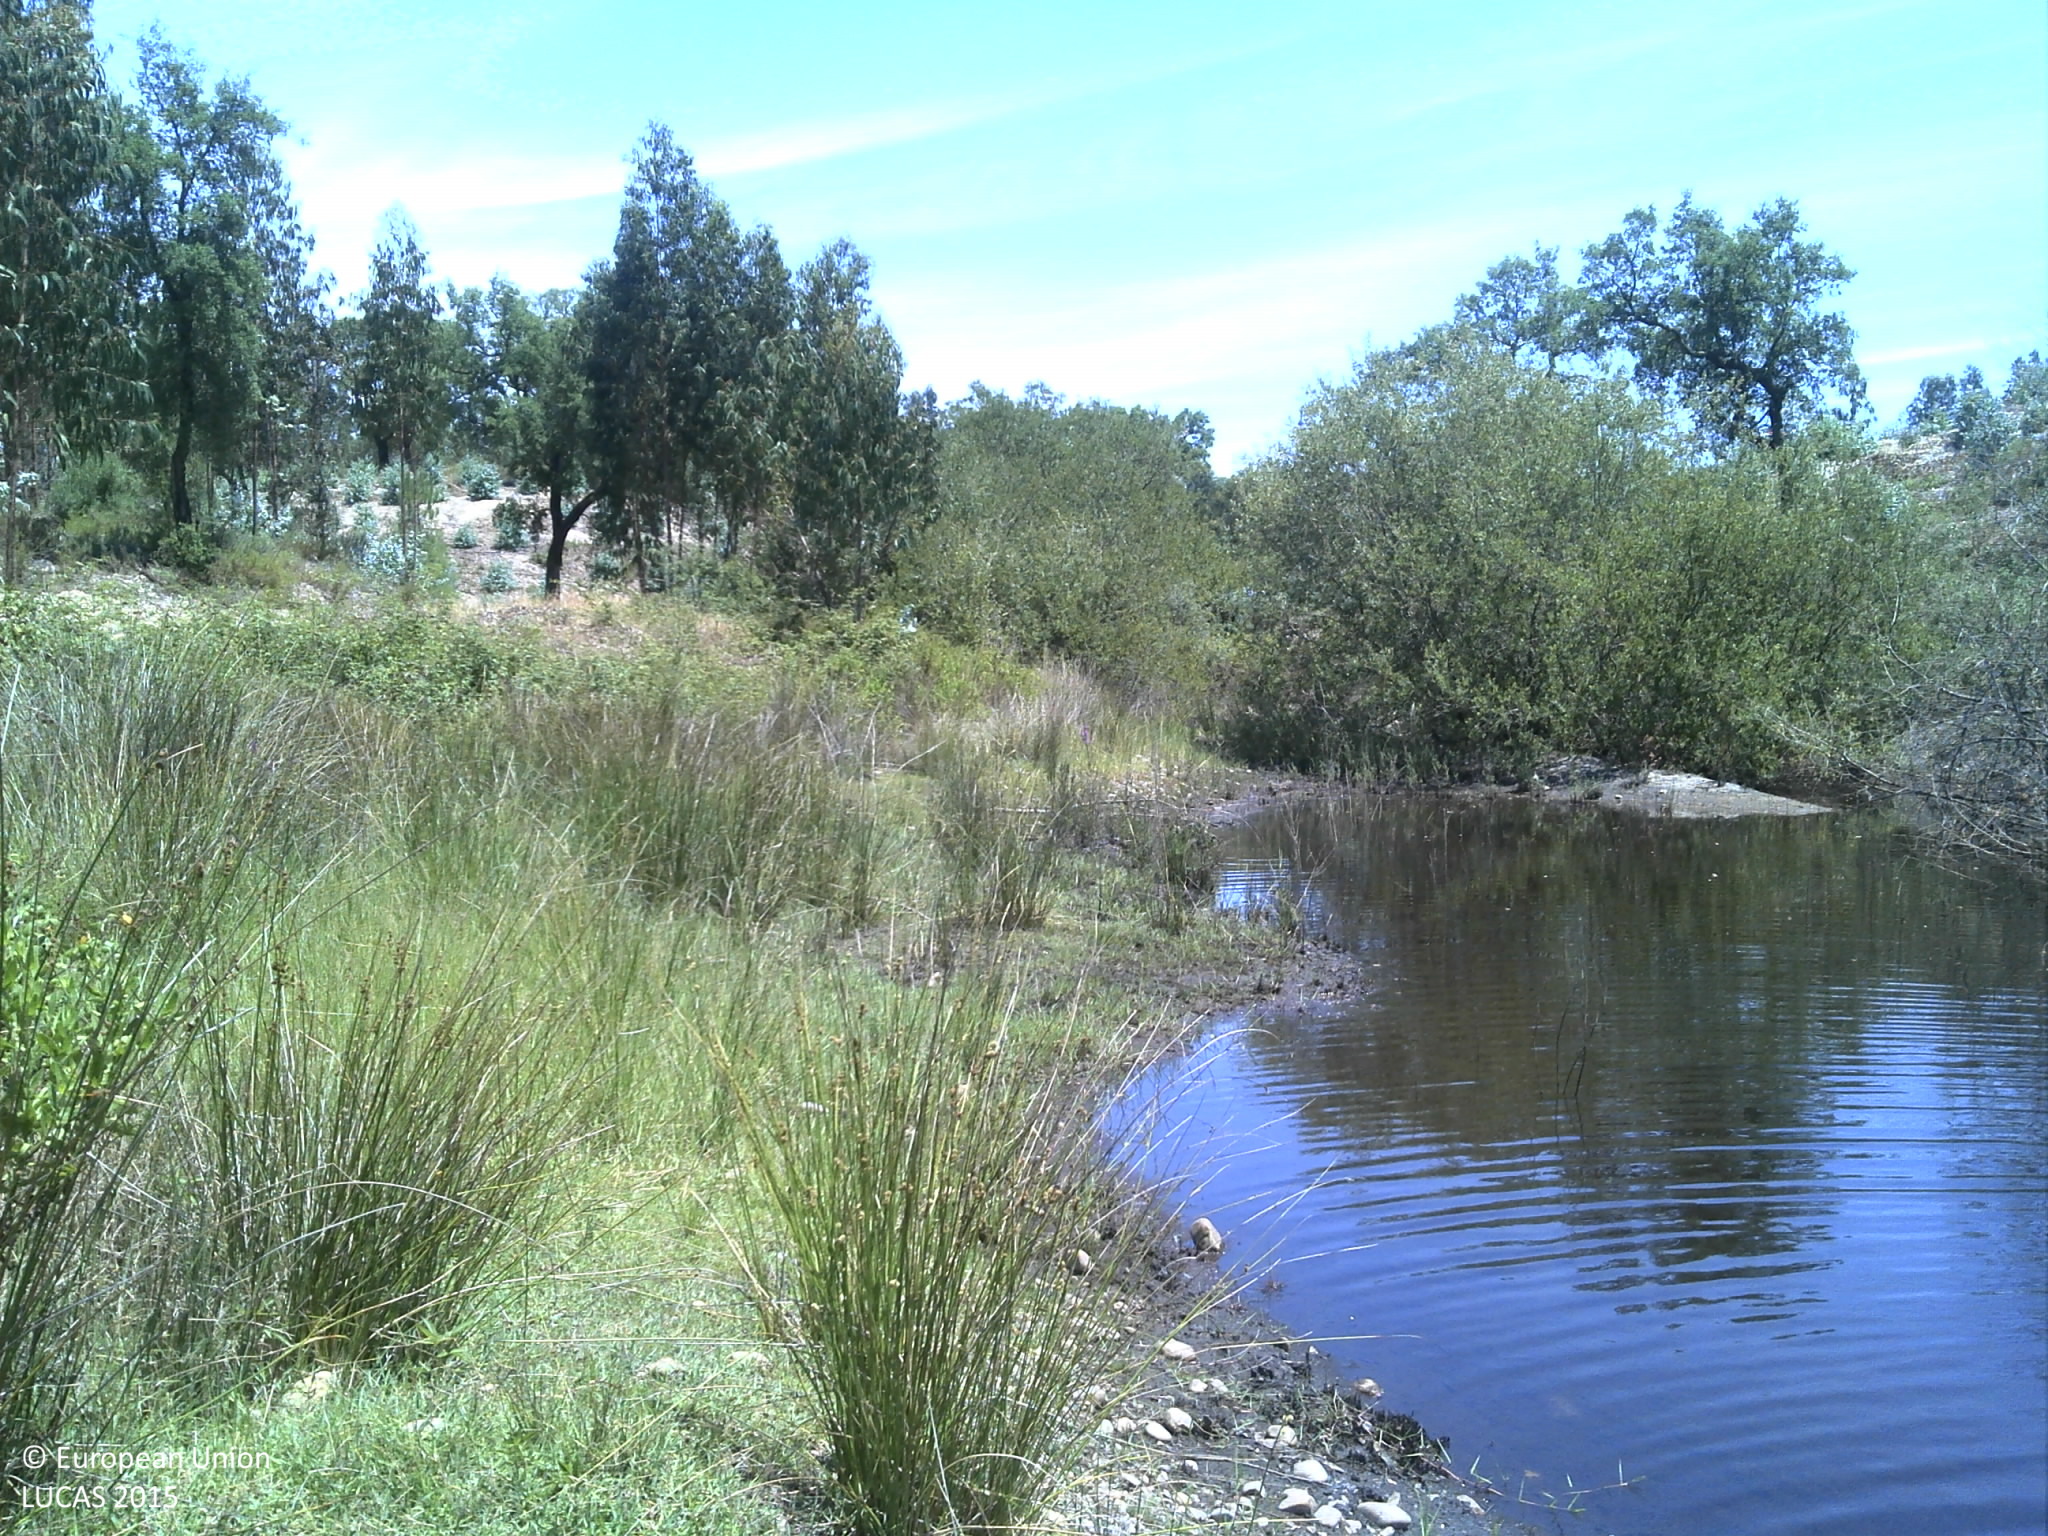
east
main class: Shrubland
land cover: Shrubland without tree cover
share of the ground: 25 - 50 %
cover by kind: unconsolidated bare surface 50 %, shrubs 40 %, herbaceous plants 10 %
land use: Semi-natural and natural areas not in use
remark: Temporary dry
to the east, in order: Shrubland without tree cover; Inland fresh water bodies; Shruby margins; Broadleaved woodland; Tracks; Broadleaved woodland; Shrubland without tree cover; Rivers and streams; Broadleaved woodland; Tracks; Broadleaved woodland
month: July
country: PT
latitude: 39.2527
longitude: -8.2901
